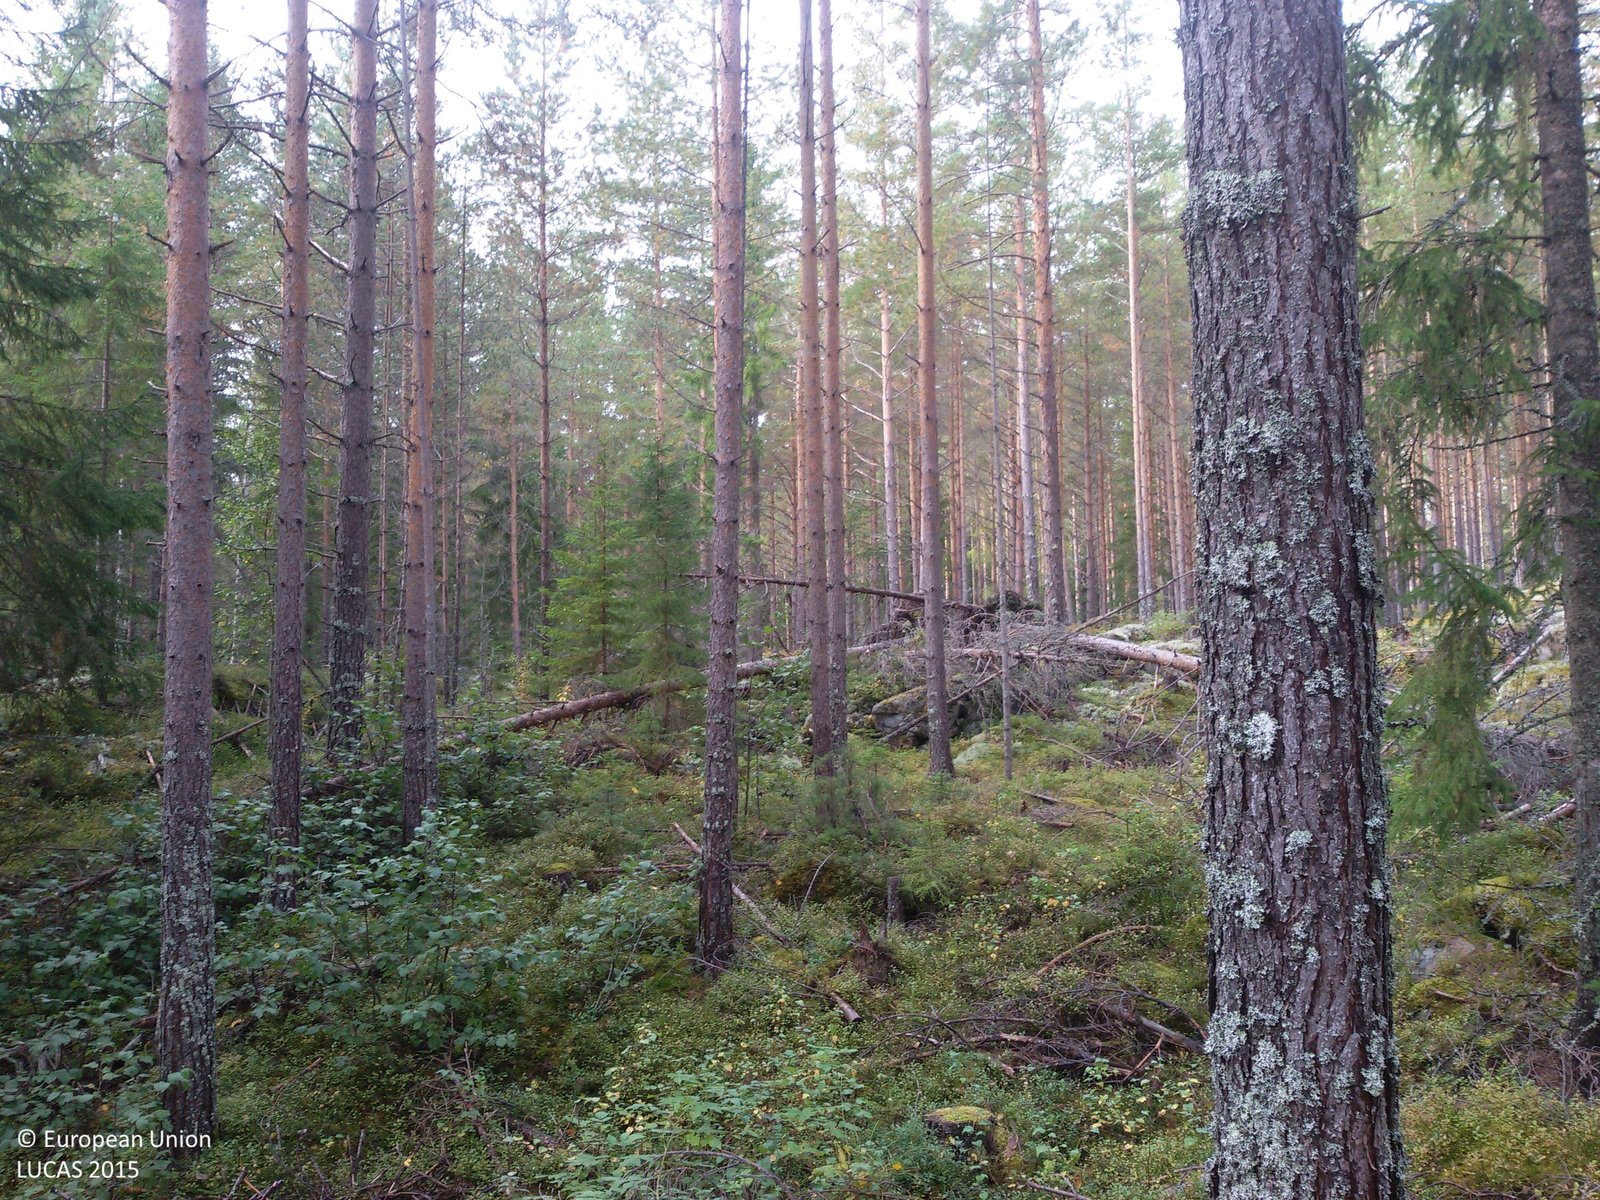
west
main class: Woodland
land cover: Pine dominated coniferous woodland
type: boreal forest
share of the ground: 50 - 75 %
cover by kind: coniferous forest trees 70 %, shrubs 20 %, lichens and mosses 10 %
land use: Forestry
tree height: > 5 m
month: September
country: SE
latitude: 60.8462
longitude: 14.5692
